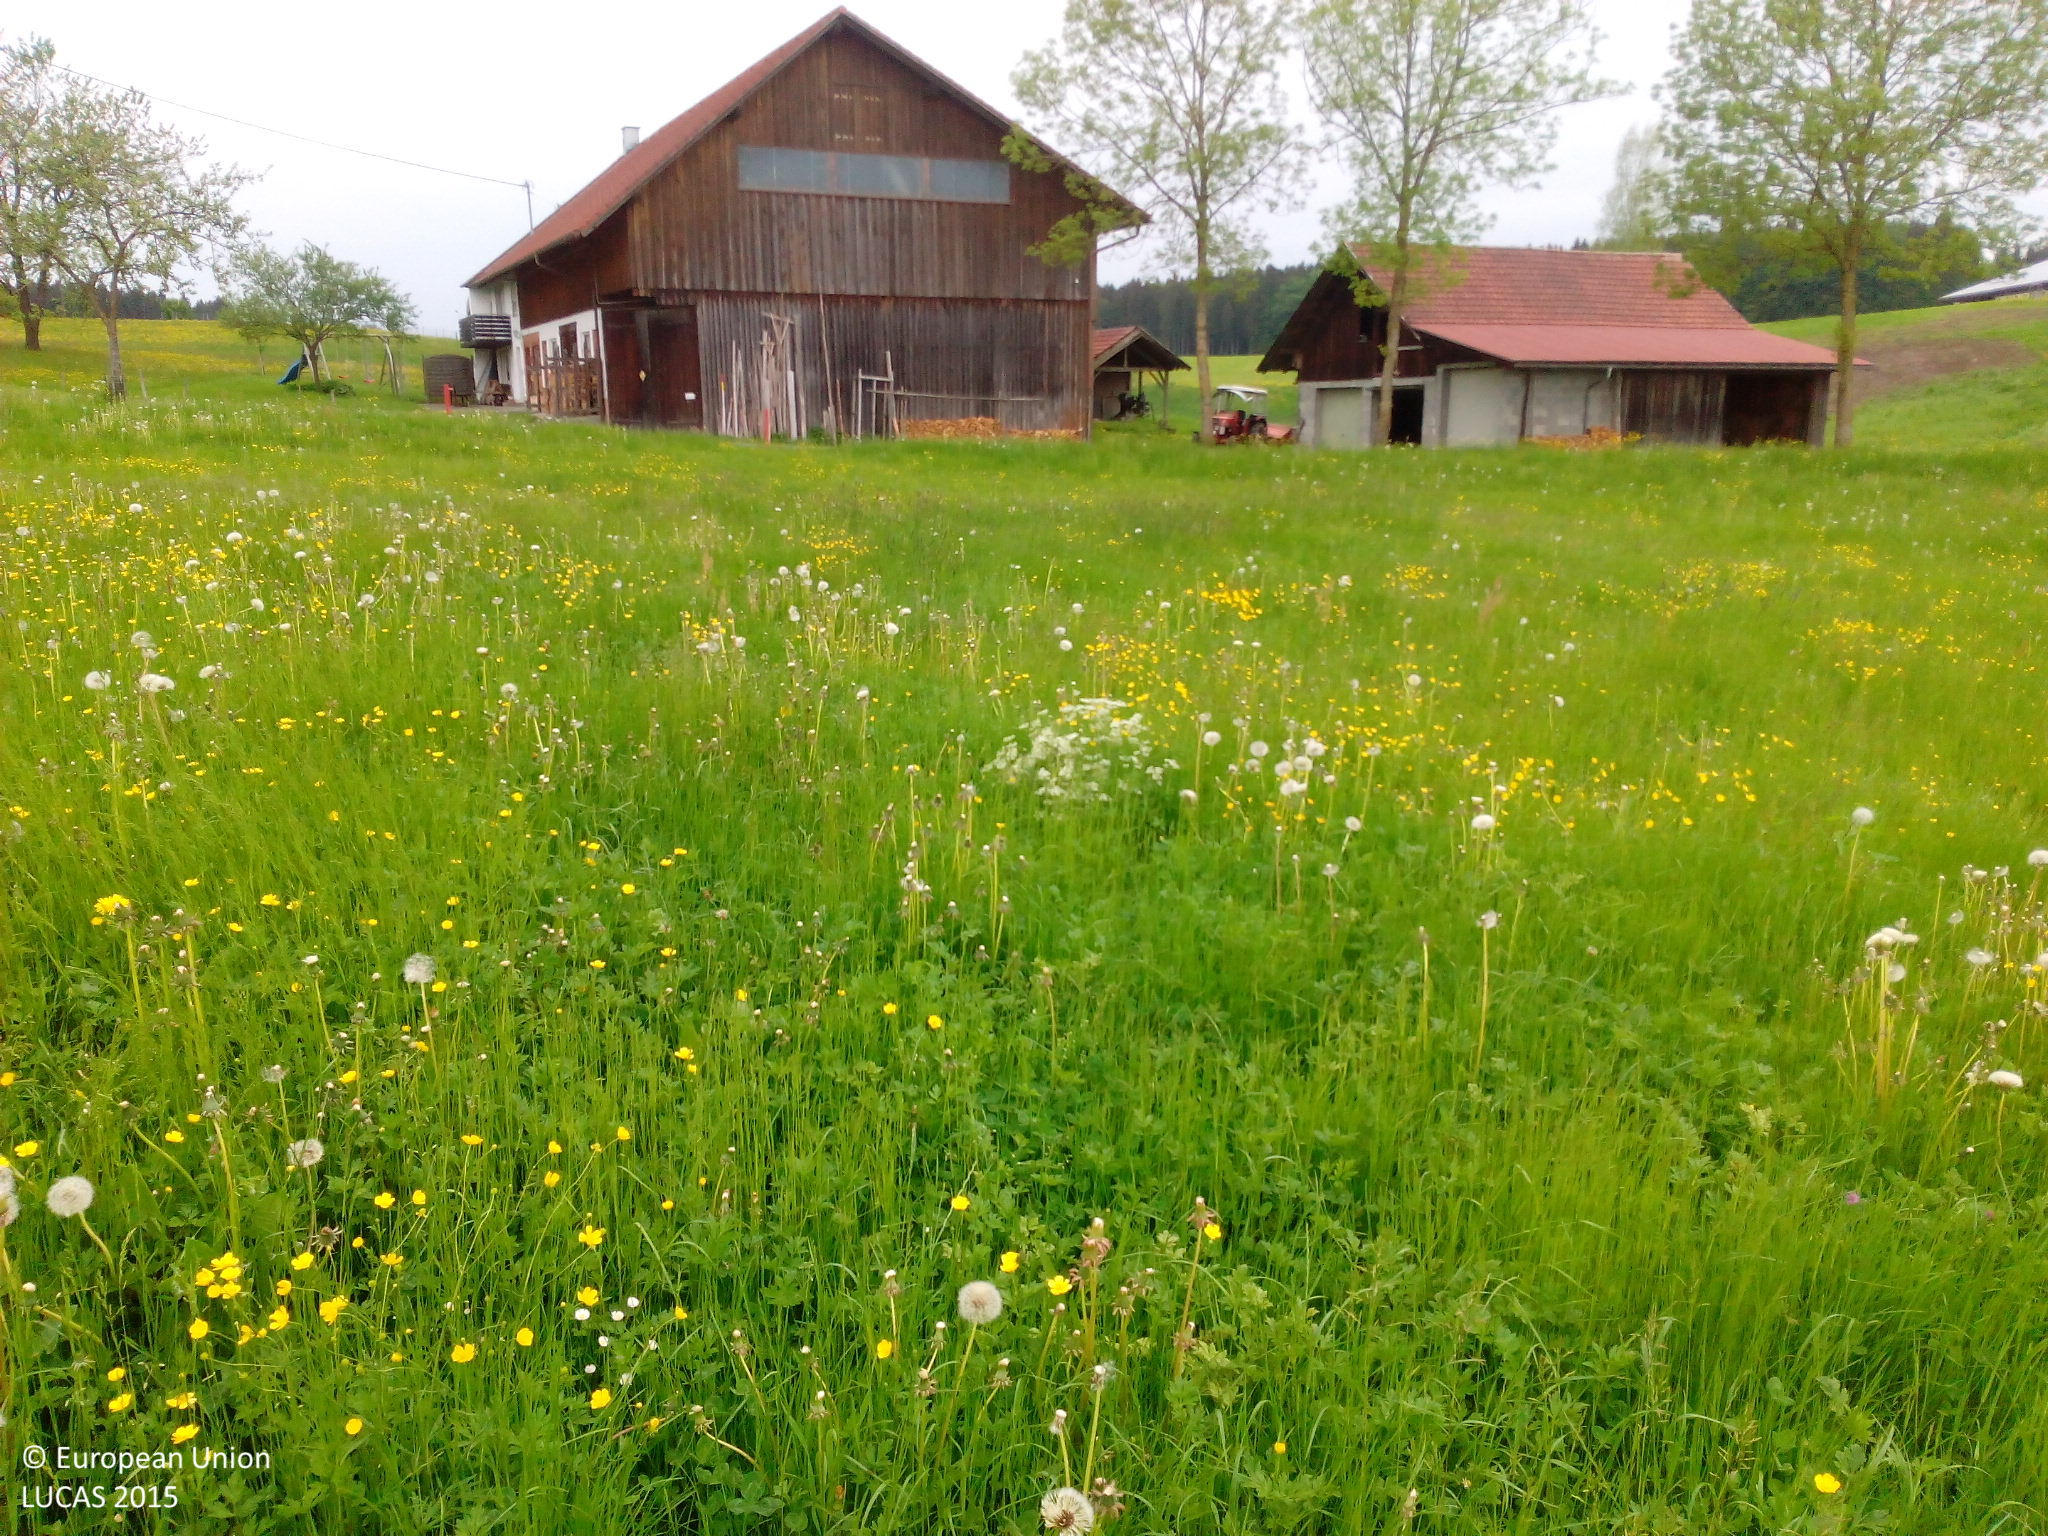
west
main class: Grassland
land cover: Grassland without tree/shrub cover
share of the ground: > 75 %
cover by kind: herbaceous plants 100 %
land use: Agriculture (excluding fallow land and kitchen gardens)
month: May
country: DE
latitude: 47.7916
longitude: 9.9333
